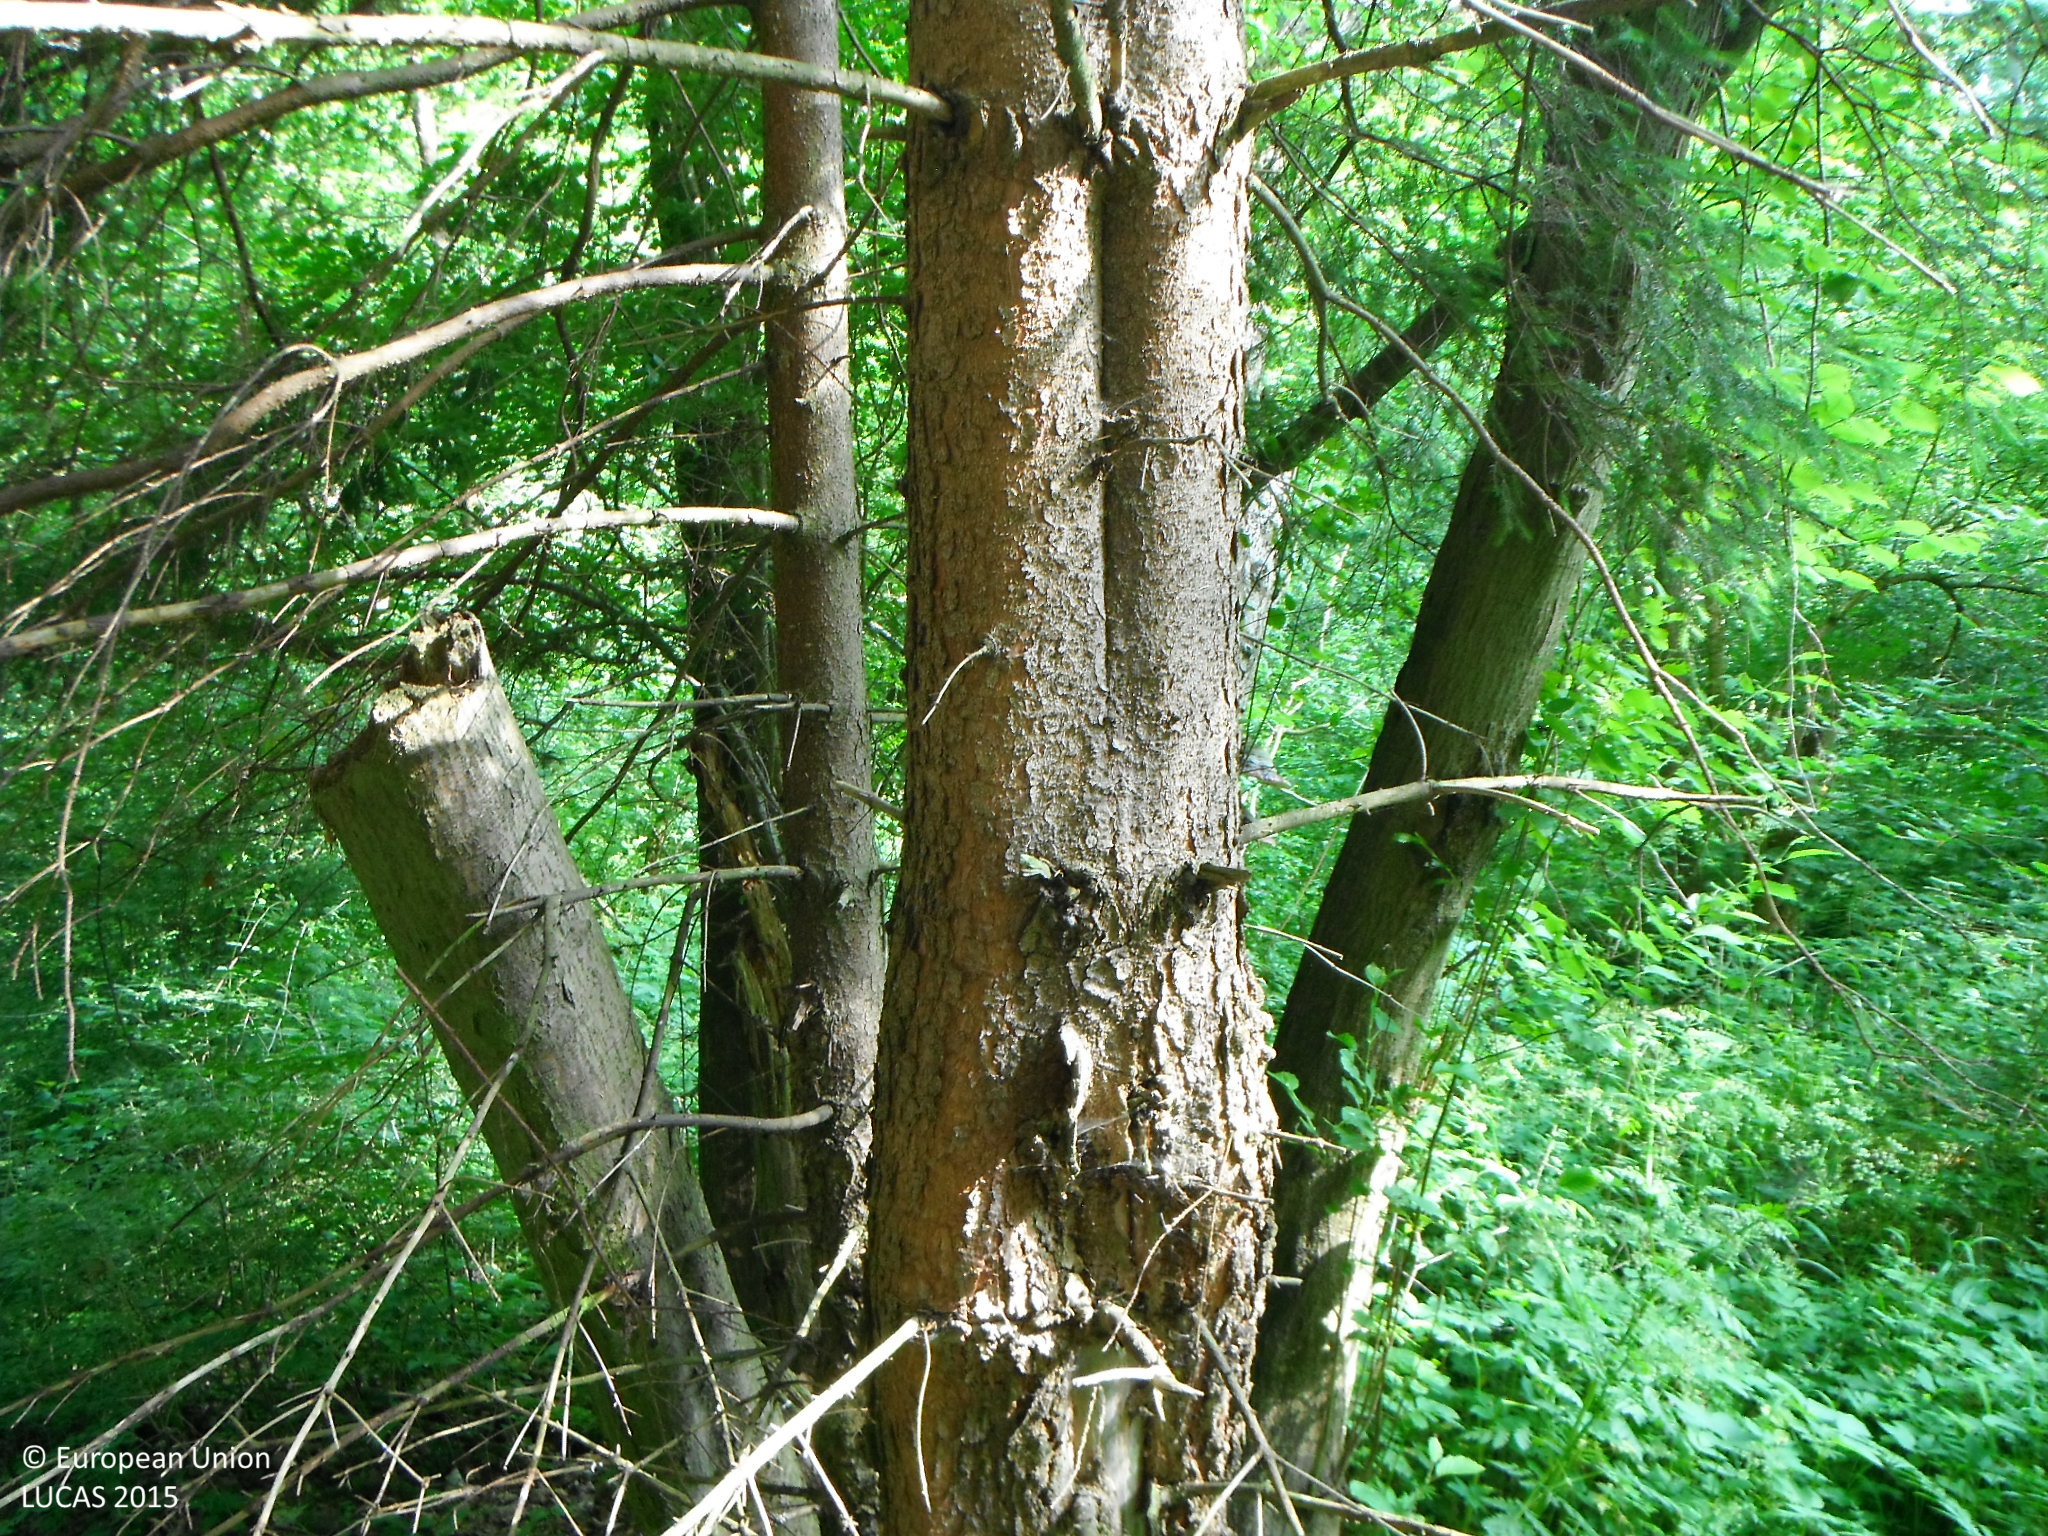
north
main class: Woodland
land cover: Spruce dominated mixed woodland
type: hemiboreal forest and nemoral coniferous forest and mixed broadleaved-coniferous forest
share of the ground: > 75 %
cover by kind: coniferous forest trees 50 %, broadleaved forest trees 50 %
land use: Forestry
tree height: > 5 m
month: July
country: SK
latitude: 49.2736
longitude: 19.3576
